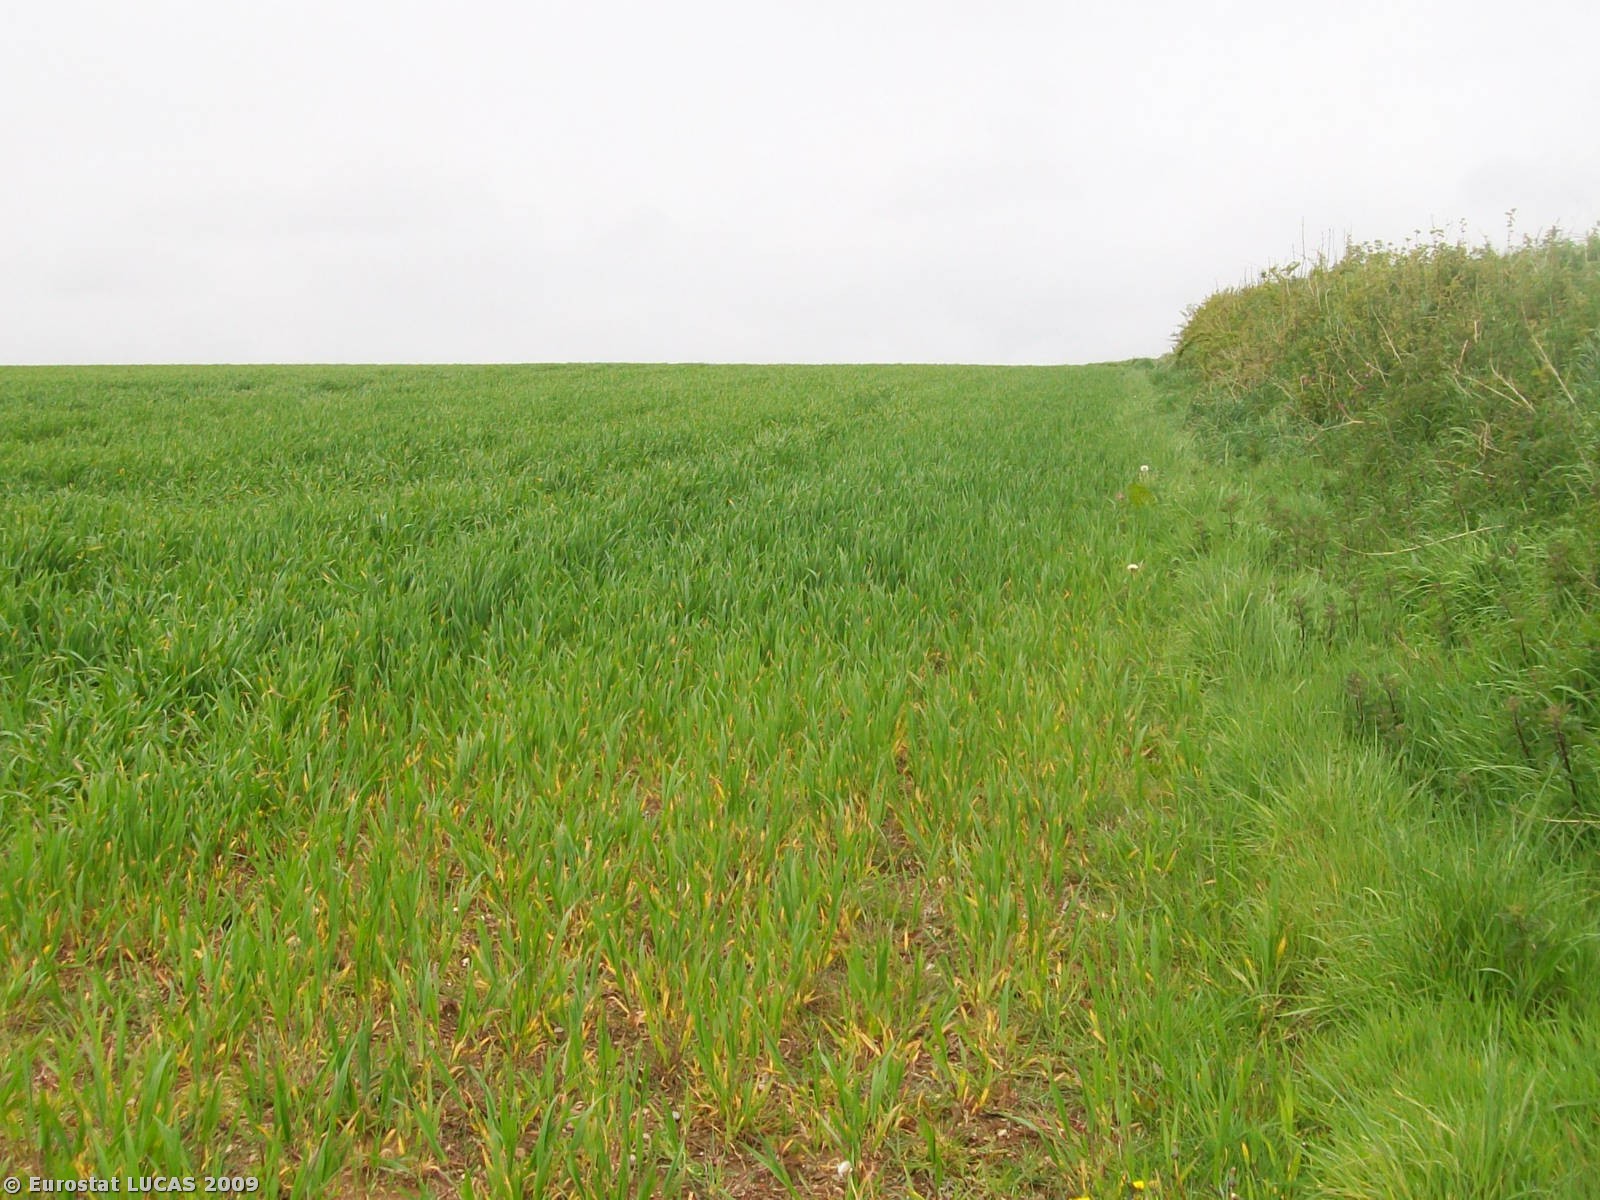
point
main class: Cropland
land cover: Common wheat
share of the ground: 50 - 75 %
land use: Agriculture (excluding fallow land and kitchen gardens)
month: May
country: GB
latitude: 50.4518
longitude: -4.5413
